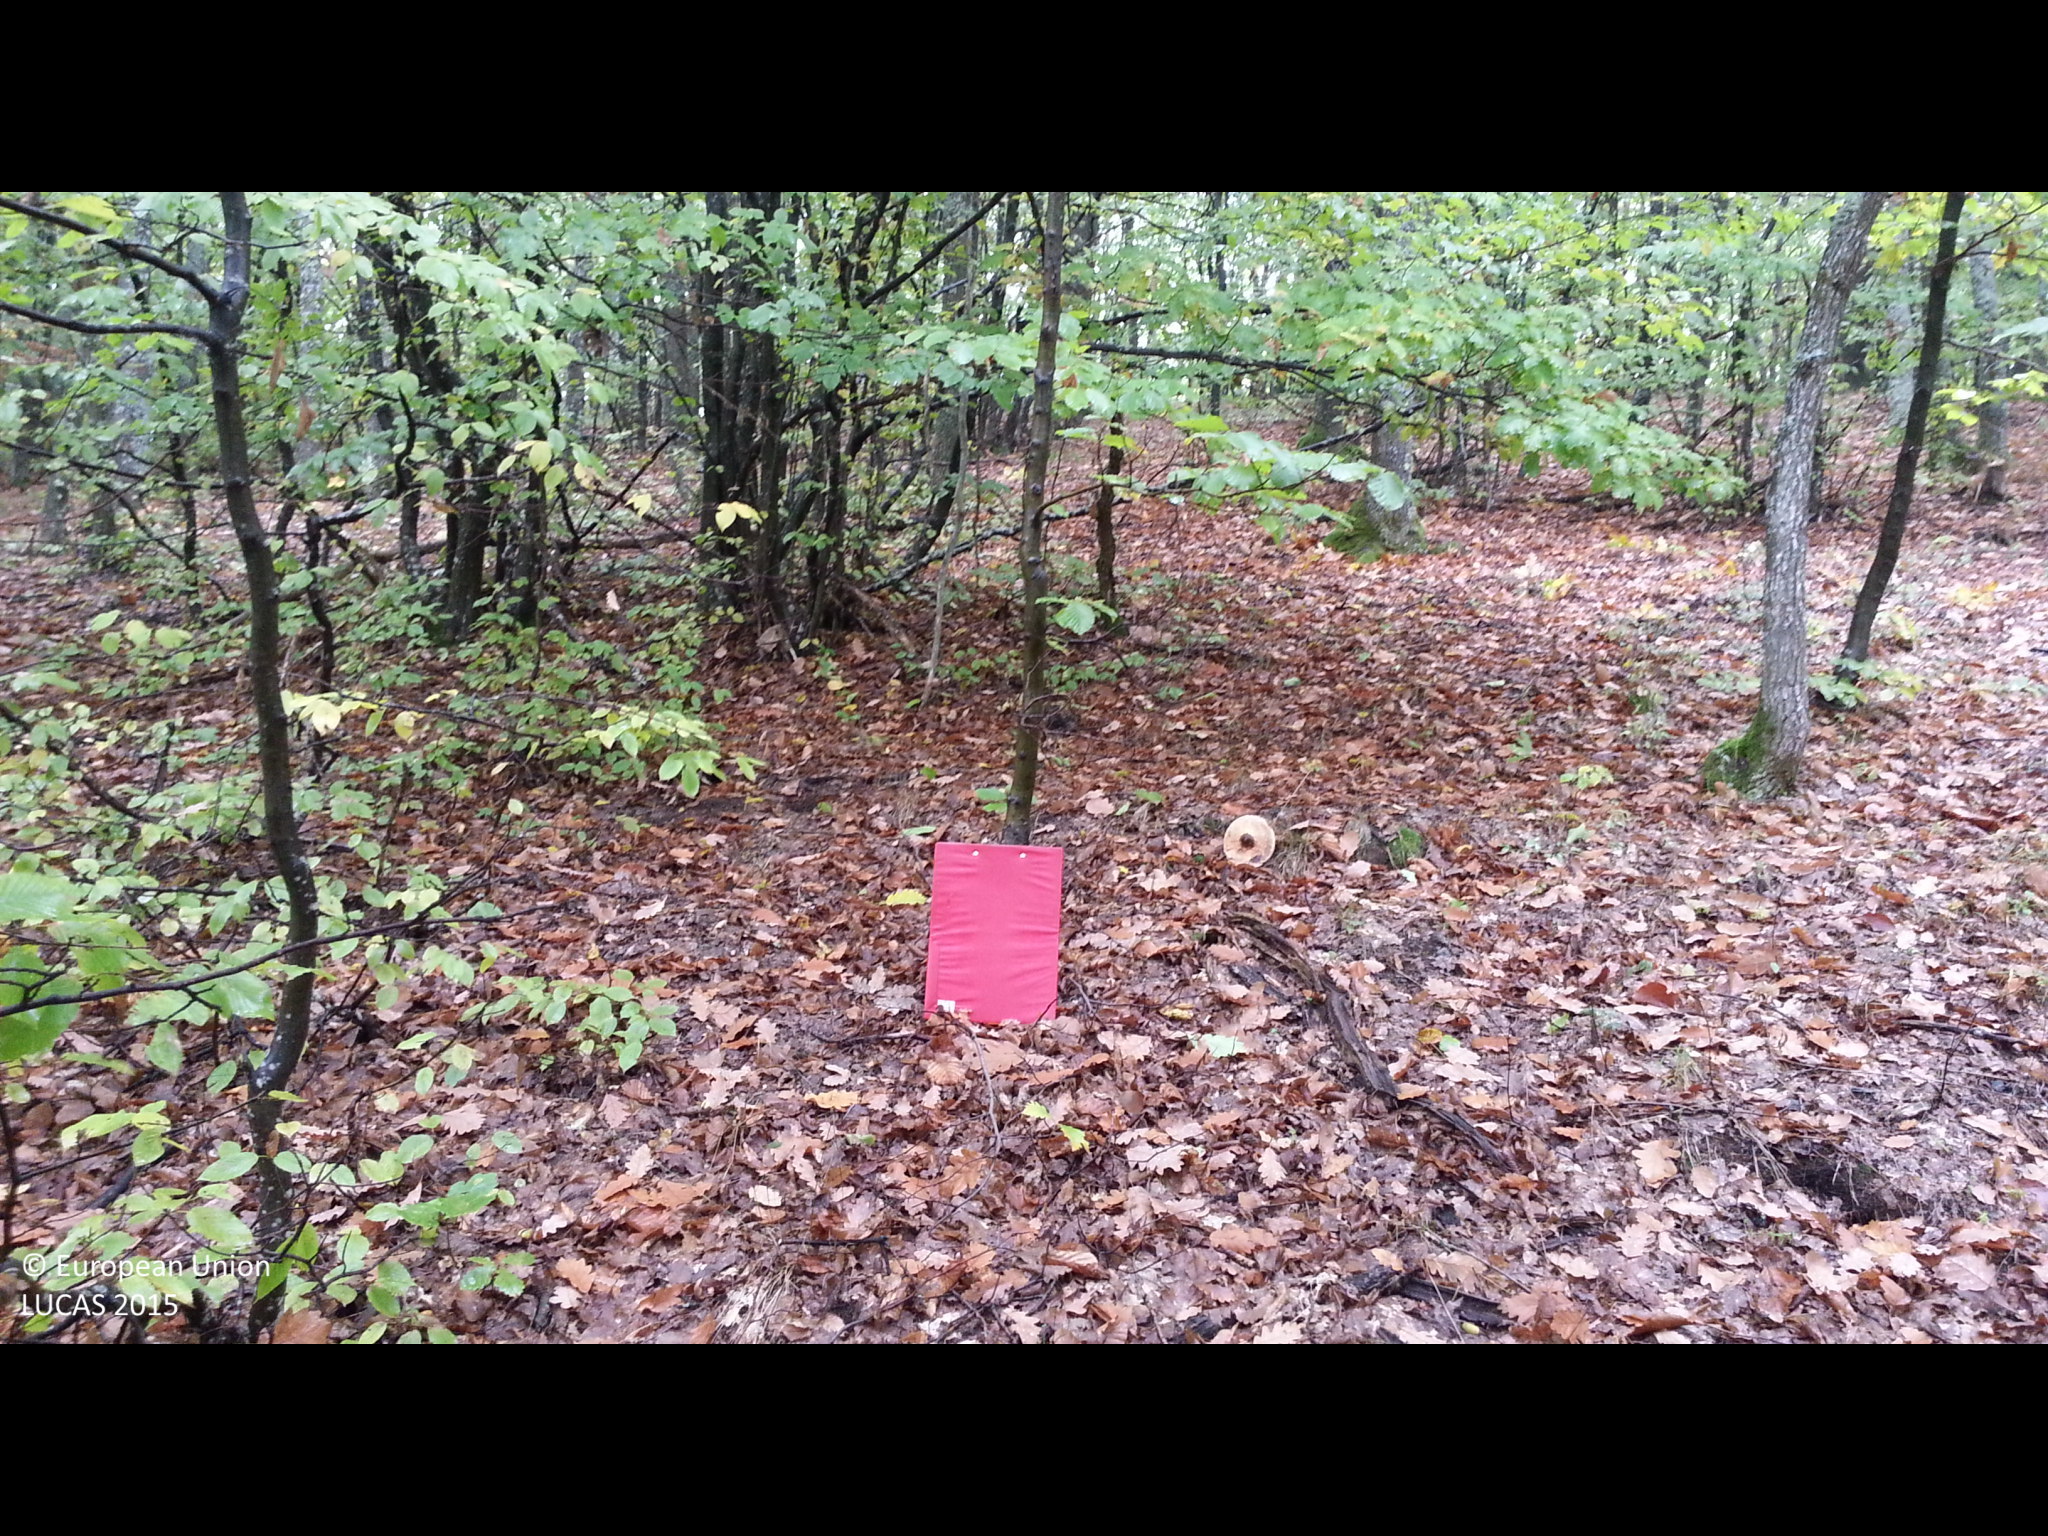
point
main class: Woodland
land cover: Broadleaved woodland
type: mesophytic deciduous forest
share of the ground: > 75 %
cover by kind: broadleaved forest trees 90 %, herbaceous plants 5 %, unconsolidated bare surface 5 %
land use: Forestry
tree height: > 5 m
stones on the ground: < 10 %
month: October
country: BG
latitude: 42.7432
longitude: 22.7189
